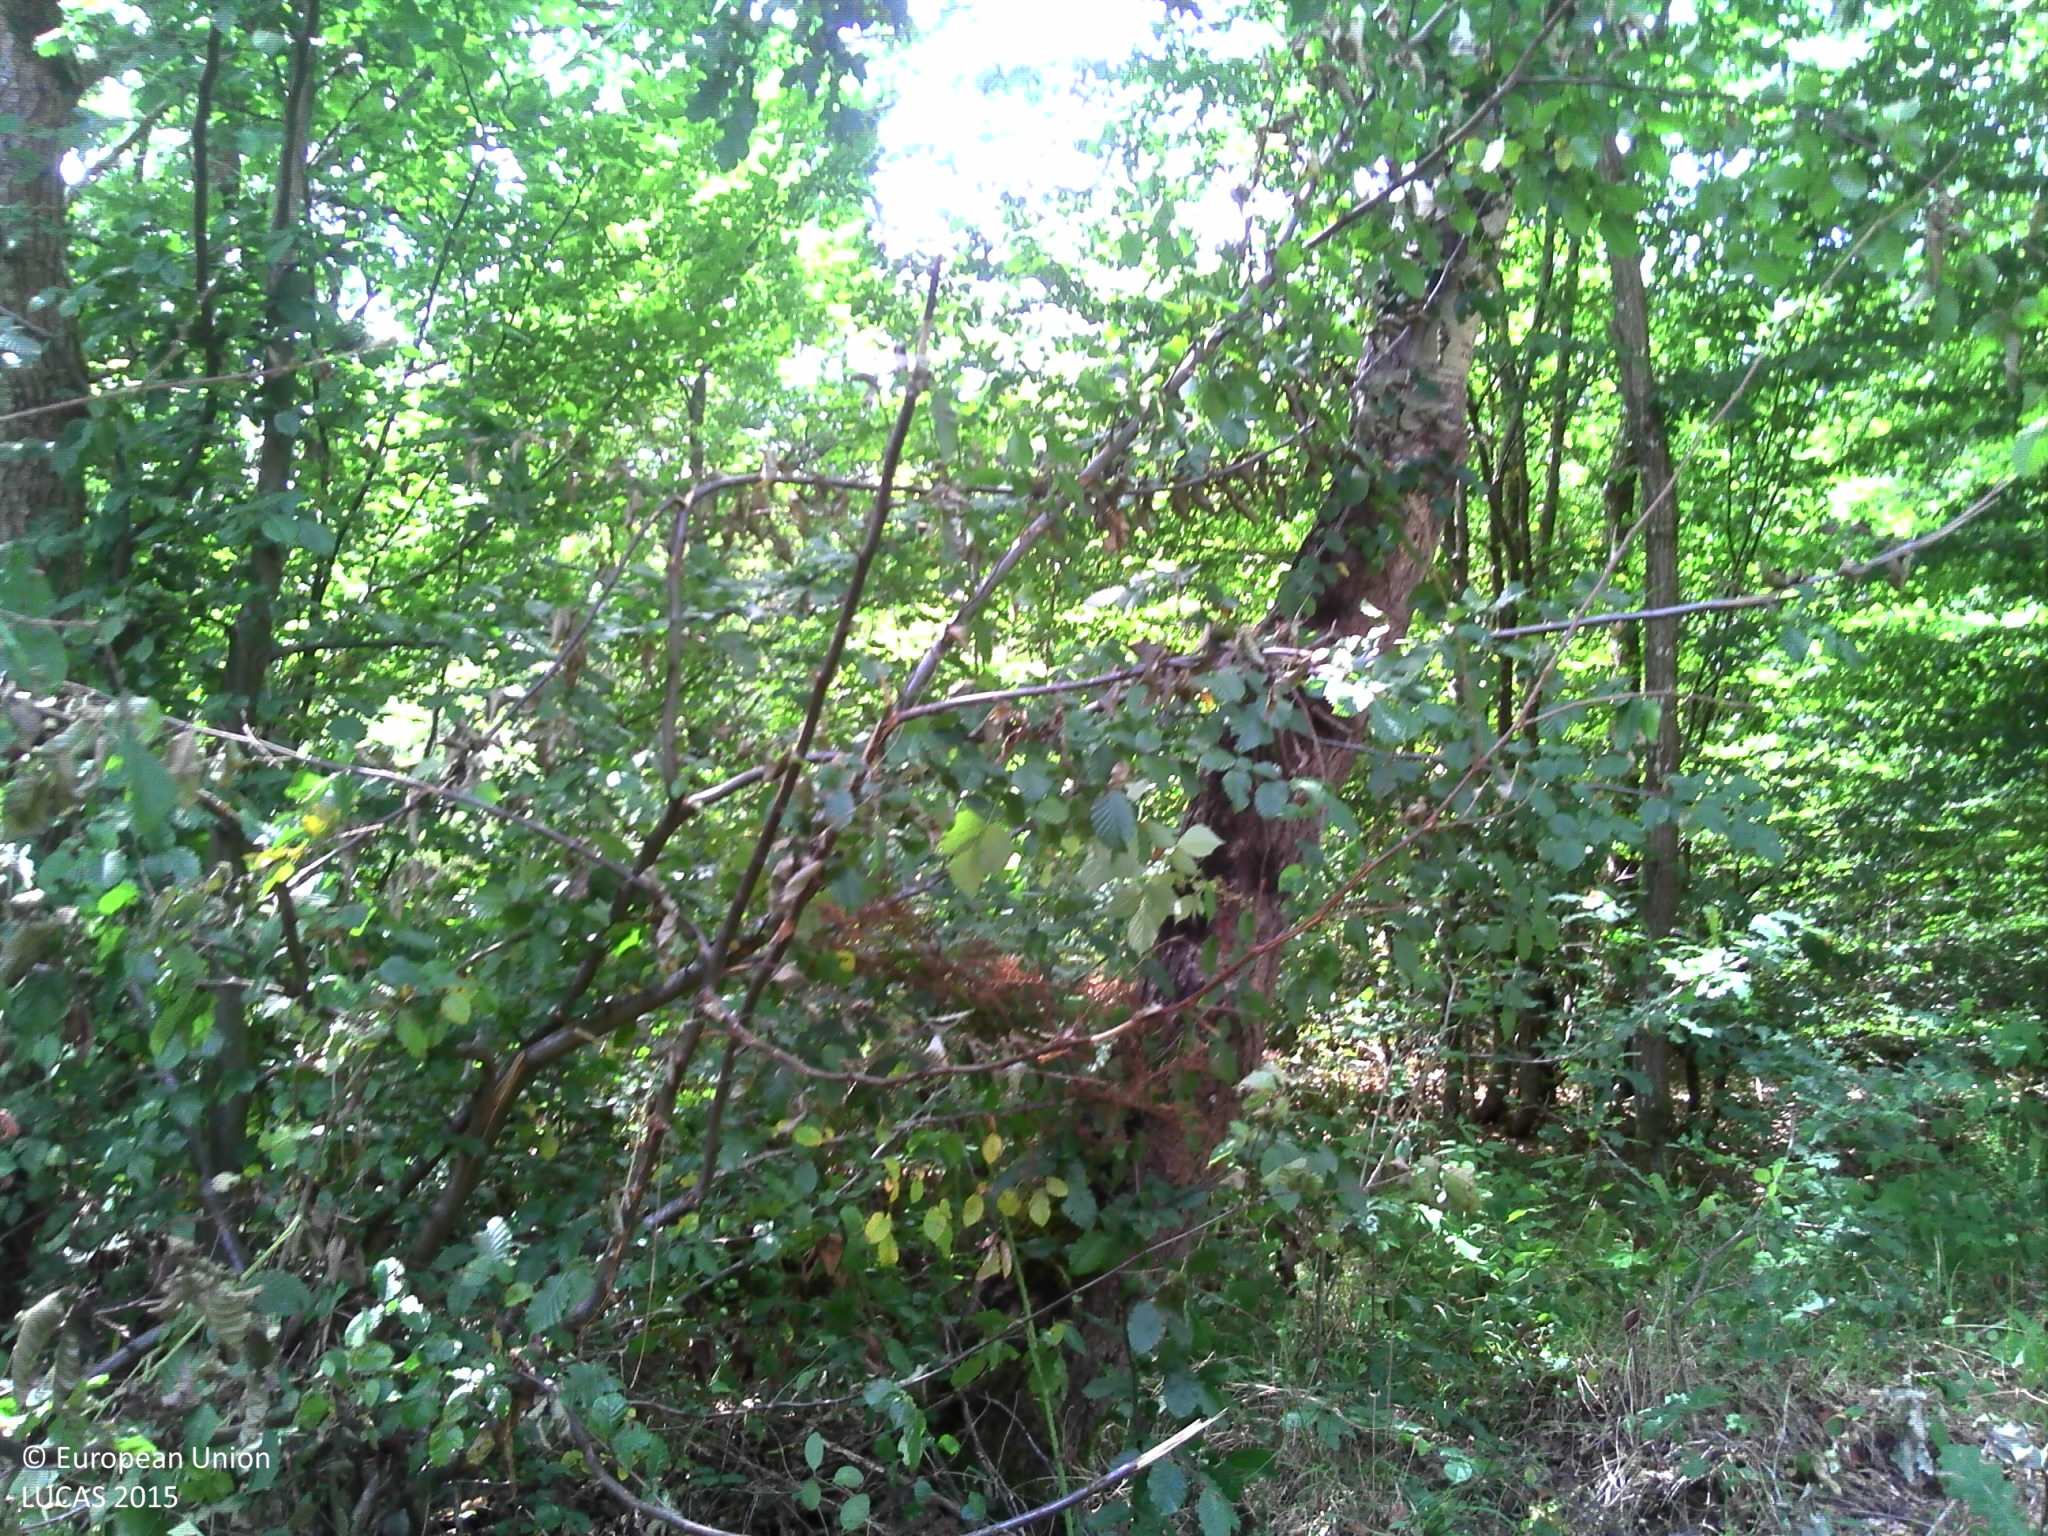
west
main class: Woodland
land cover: Broadleaved woodland
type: mesophytic deciduous forest
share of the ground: > 75 %
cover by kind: broadleaved forest trees 100 %
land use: Forestry
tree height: > 5 m
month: July
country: FR
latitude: 47.9840
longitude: 1.9619
